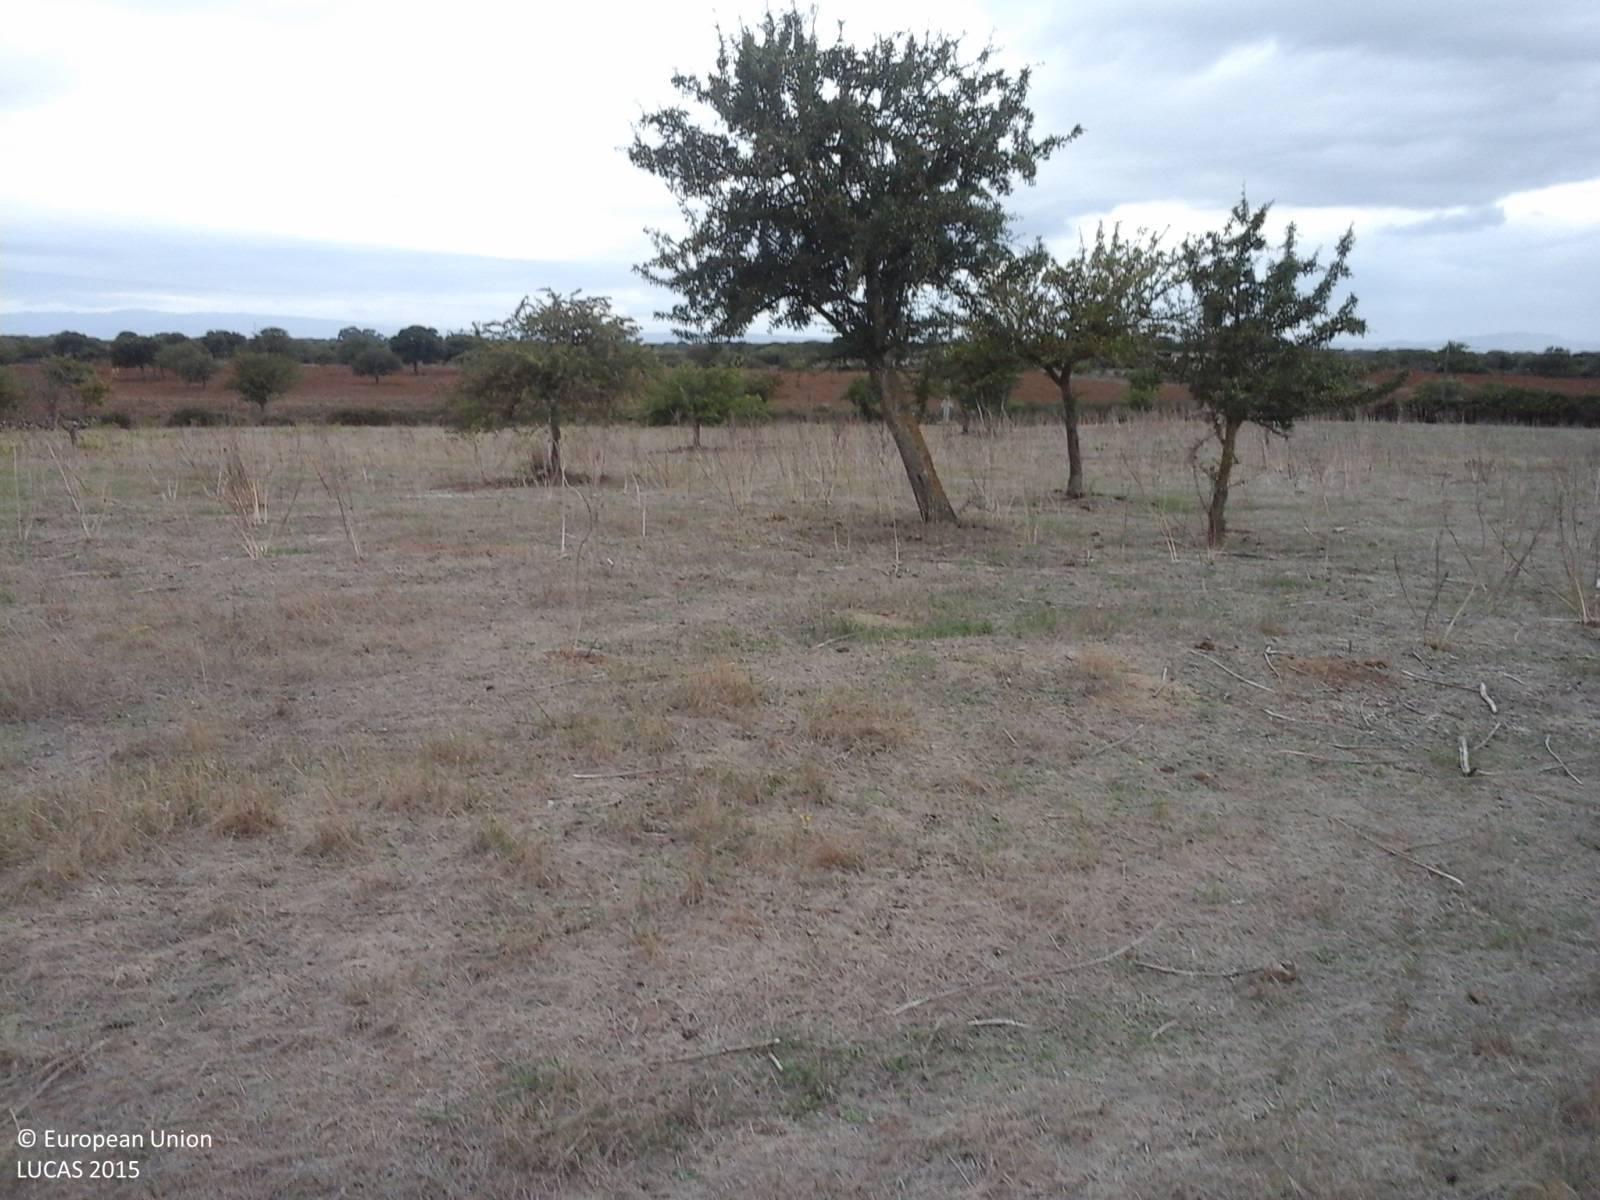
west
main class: Grassland
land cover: Grassland without tree/shrub cover
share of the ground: 50 - 75 %
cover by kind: herbaceous plants 100 %
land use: Agriculture (excluding fallow land and kitchen gardens)
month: September
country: IT
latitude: 40.1886
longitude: 8.8901
